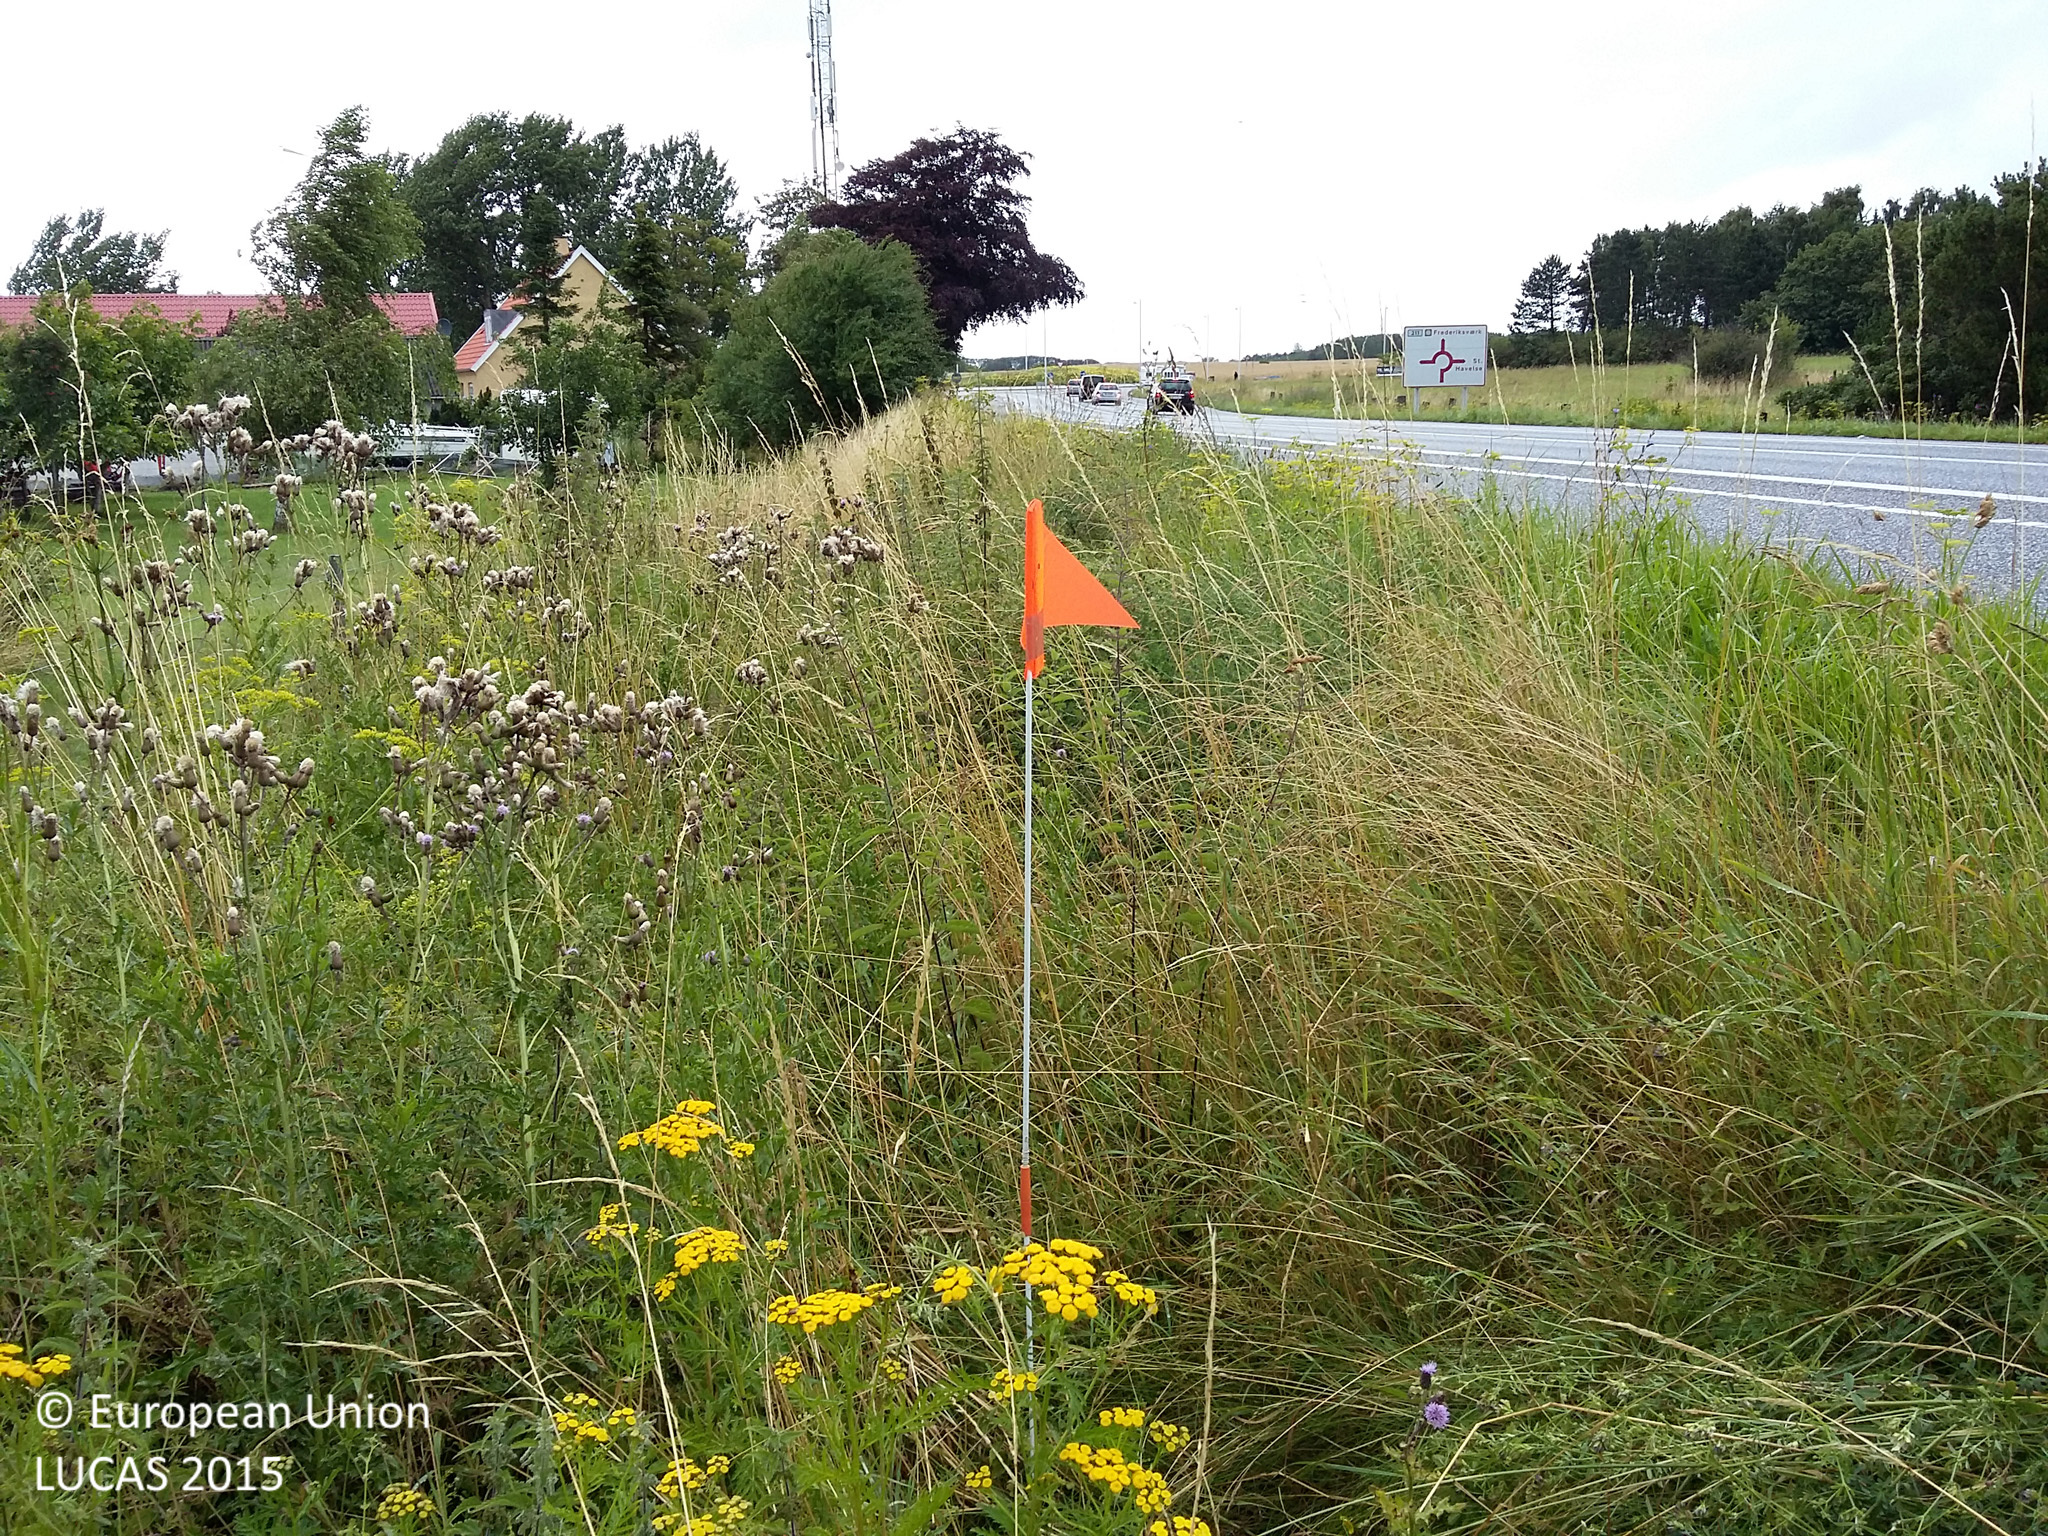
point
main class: Grassland
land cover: Spontaneously vegetated surfaces
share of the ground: > 75 %
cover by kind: herbaceous plants 100 %
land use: Semi-natural and natural areas not in use
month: July
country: DK
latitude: 55.9015
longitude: 12.0613
